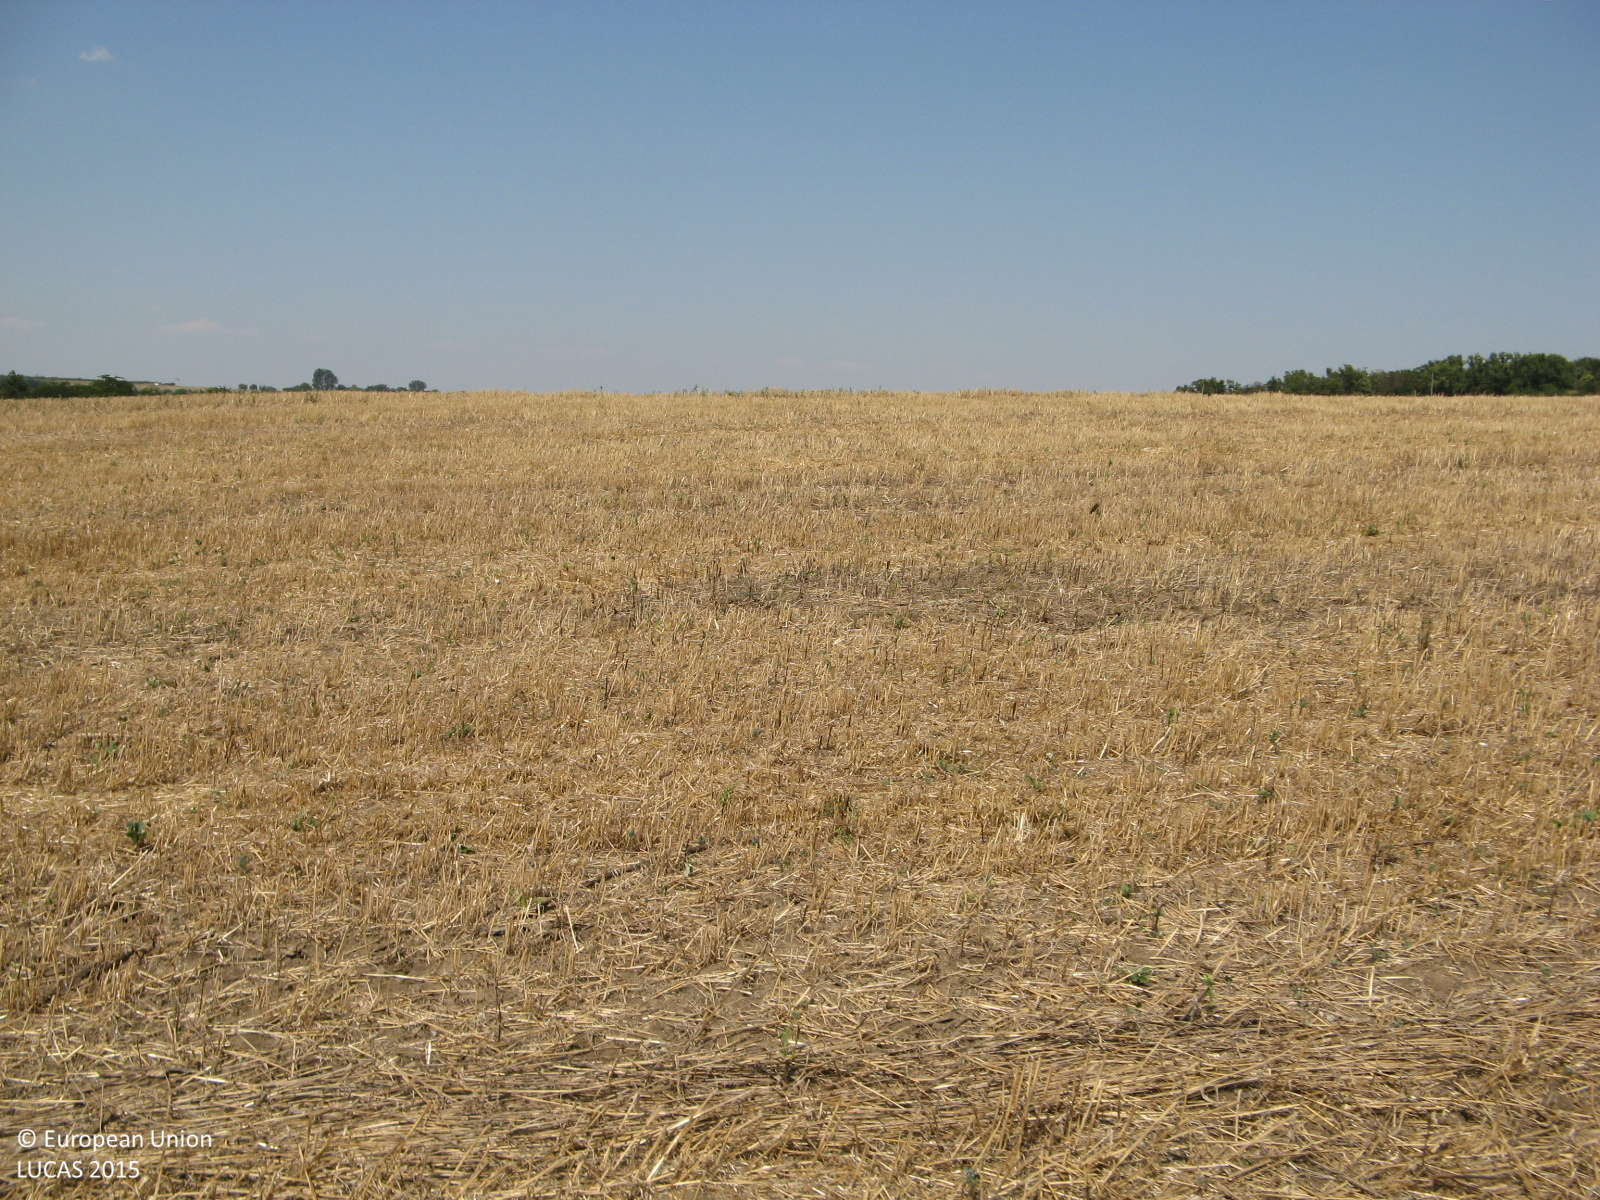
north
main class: Cropland
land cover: Common wheat
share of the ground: 50 - 75 %
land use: Agriculture (excluding fallow land and kitchen gardens)
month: August
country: BG
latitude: 43.3666
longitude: 25.3418
